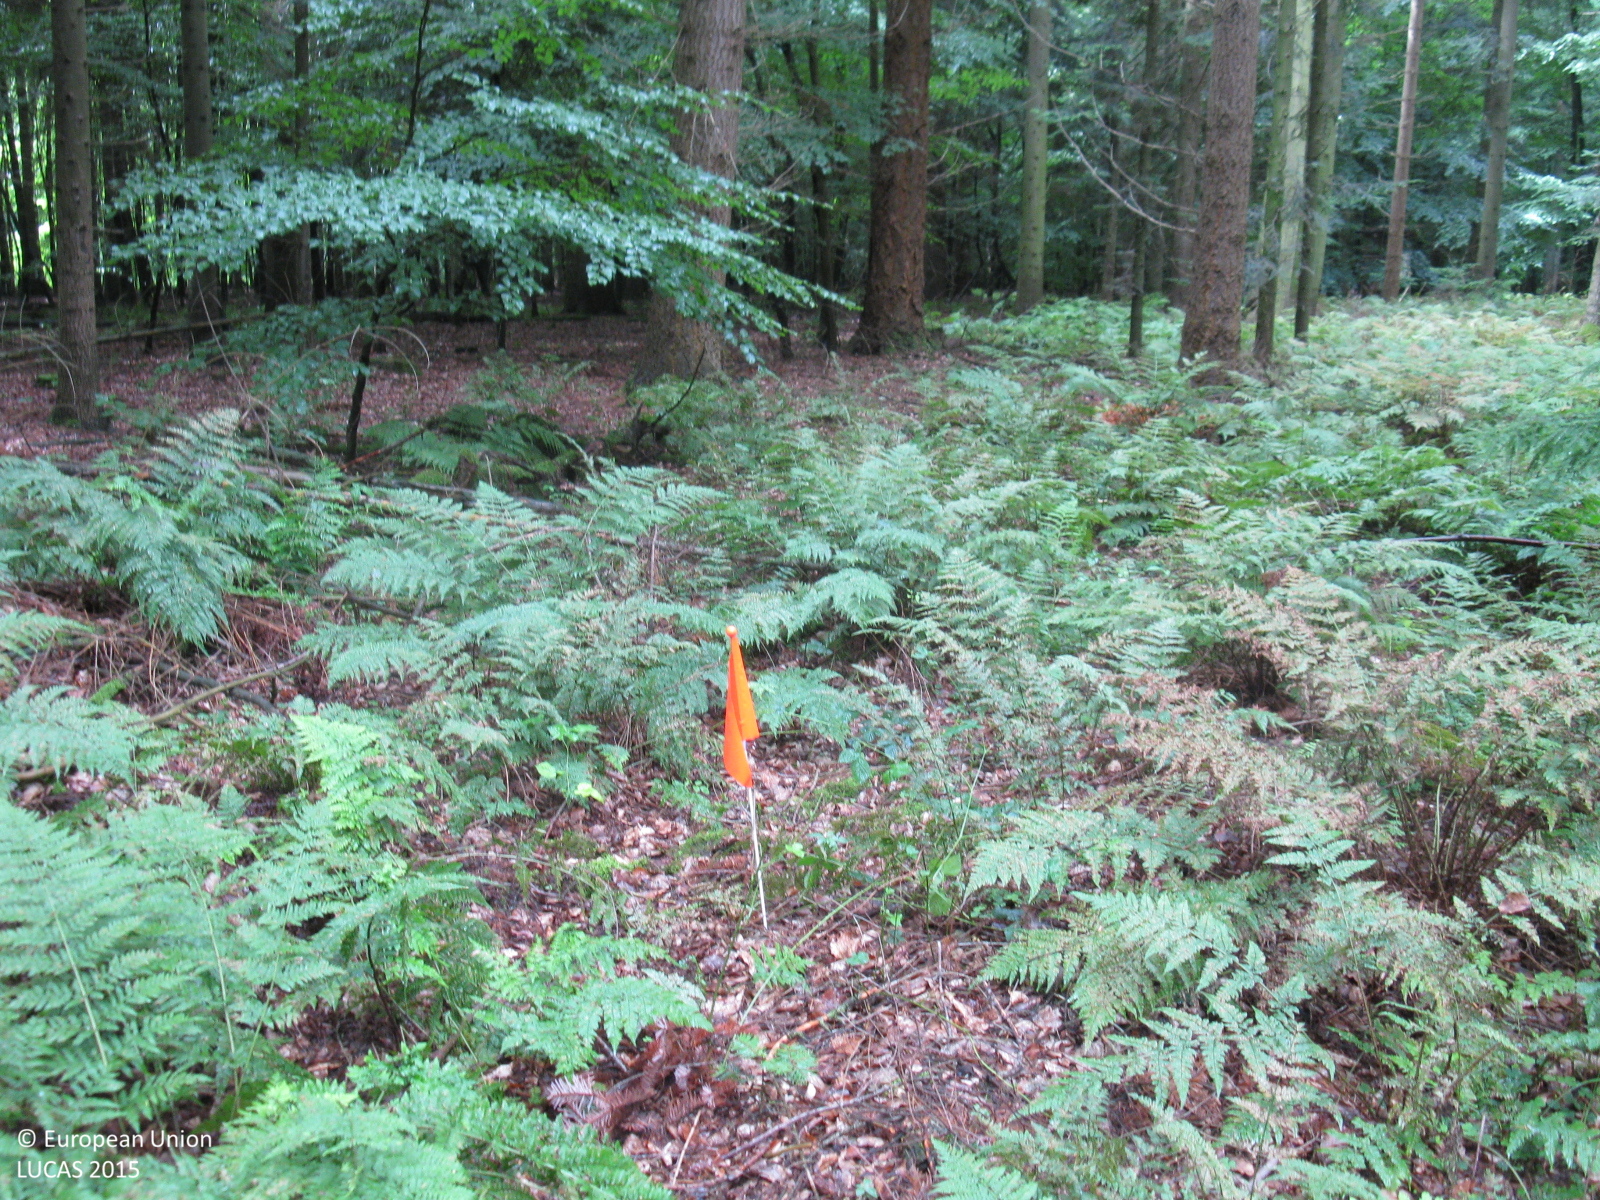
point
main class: Woodland
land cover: Other coniferous woodland
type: hemiboreal forest and nemoral coniferous forest and mixed broadleaved-coniferous forest
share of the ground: > 75 %
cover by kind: coniferous forest trees 100 %
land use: Forestry
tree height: > 5 m
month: July
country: DE
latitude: 52.9263
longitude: 8.5874
